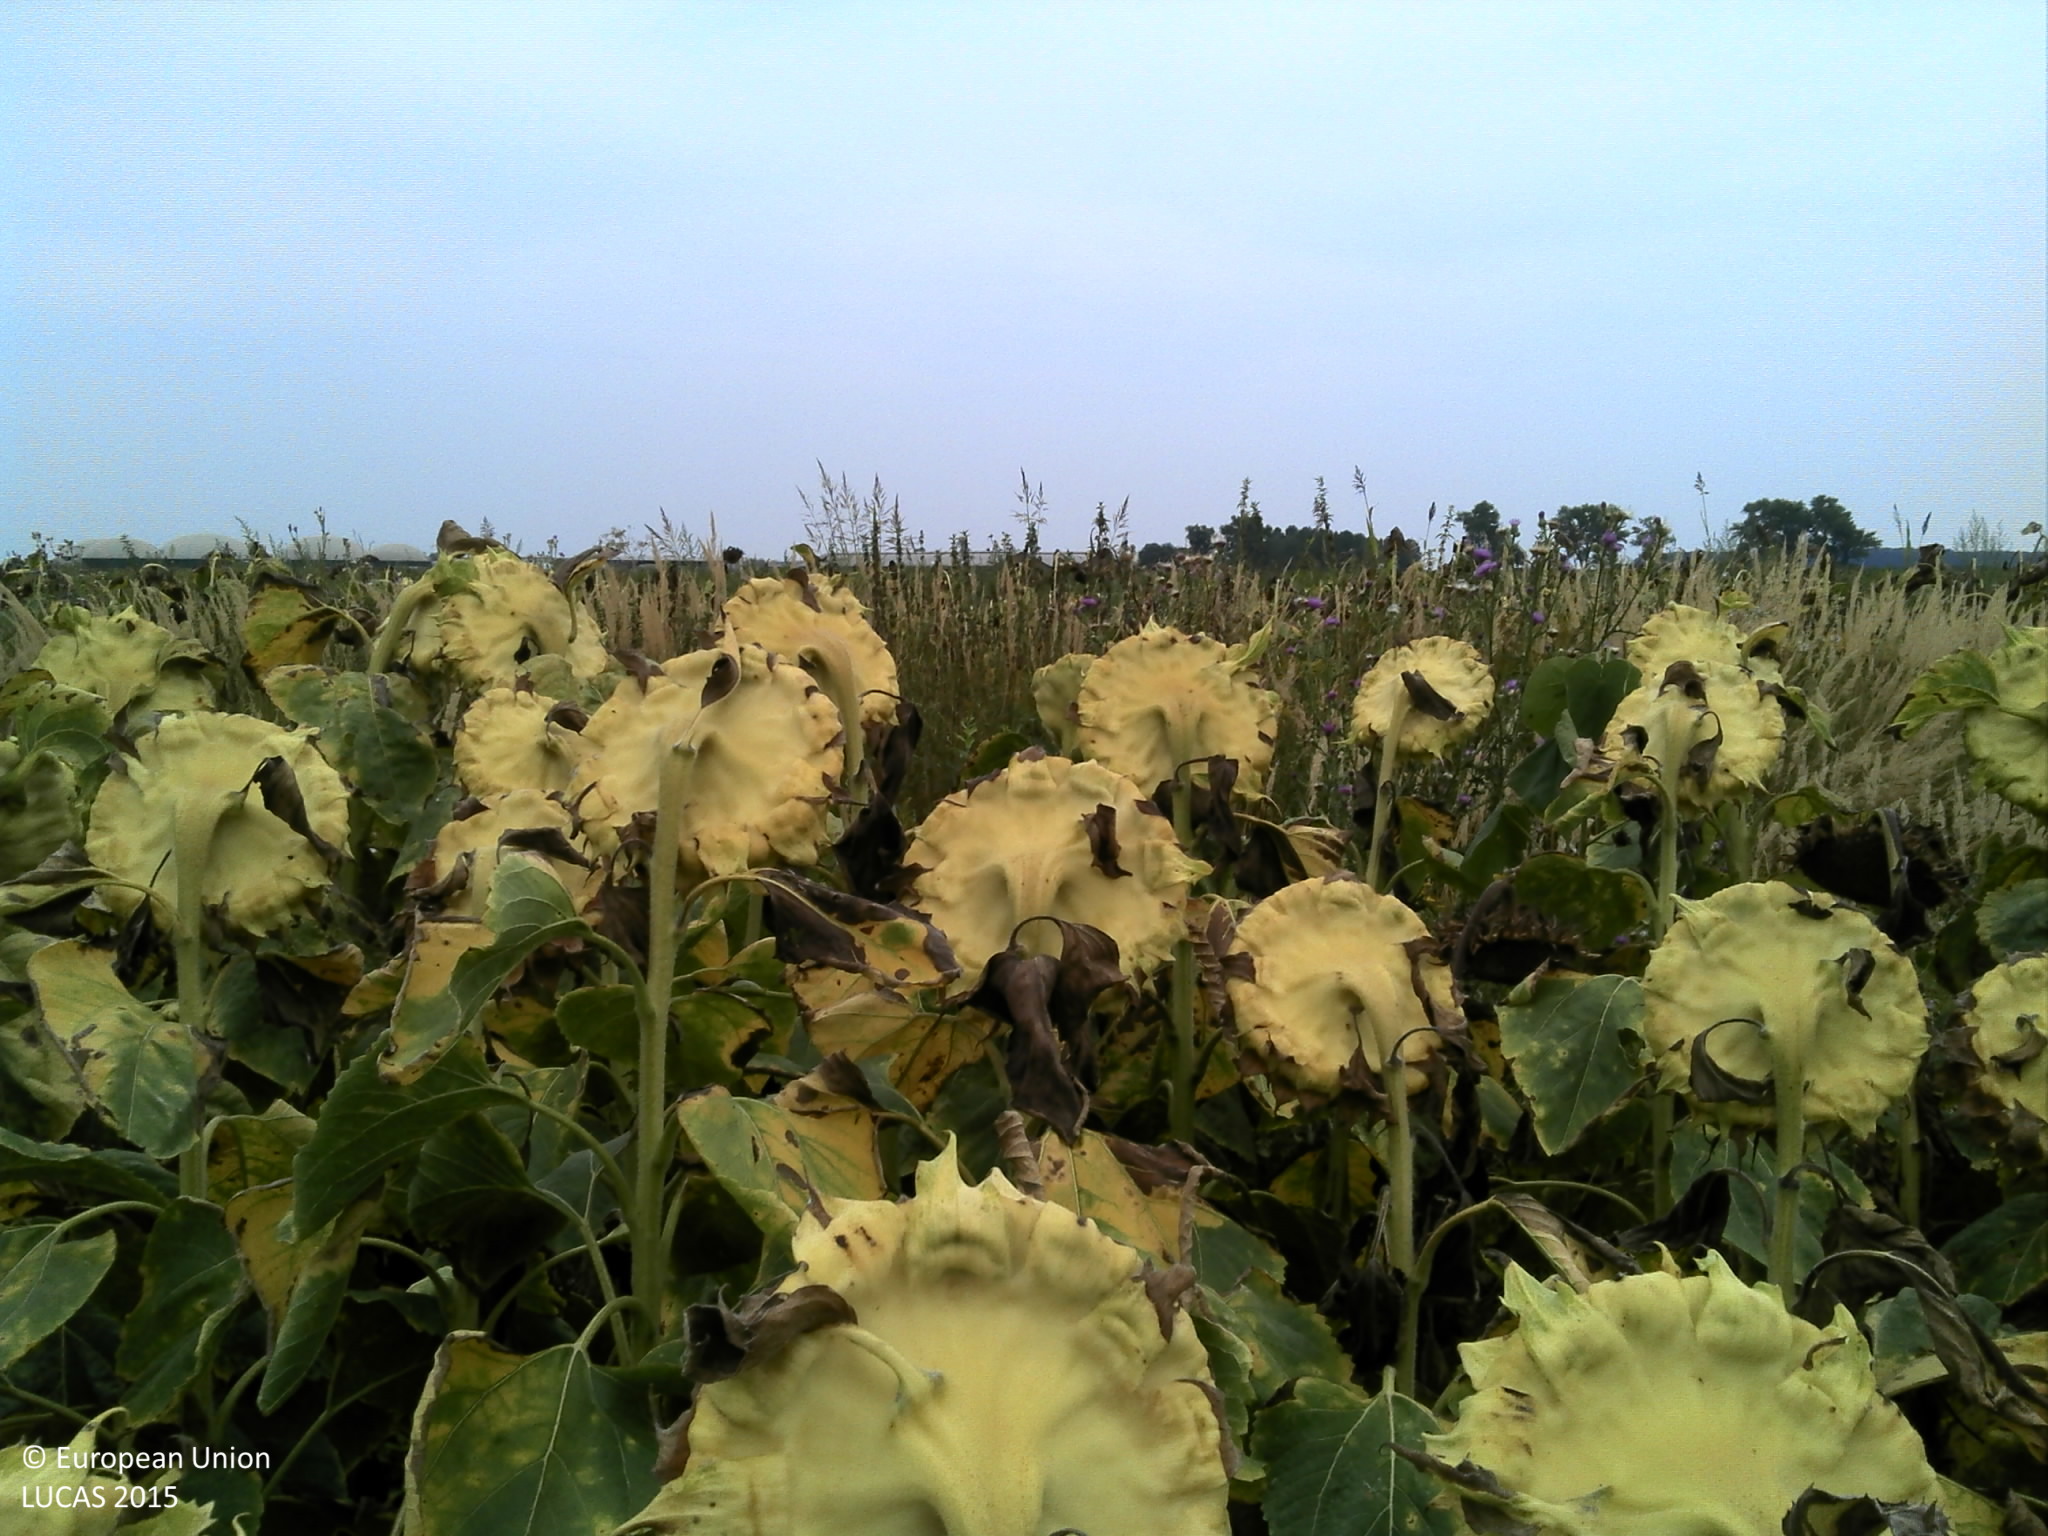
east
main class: Cropland
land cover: Sunflower
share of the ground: > 75 %
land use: Agriculture (excluding fallow land and kitchen gardens)
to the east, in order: Sunflower; Ditches and canals; Sunflower; Ditches and canals; Sunflower
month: August
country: HR
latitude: 45.4681
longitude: 18.5119
